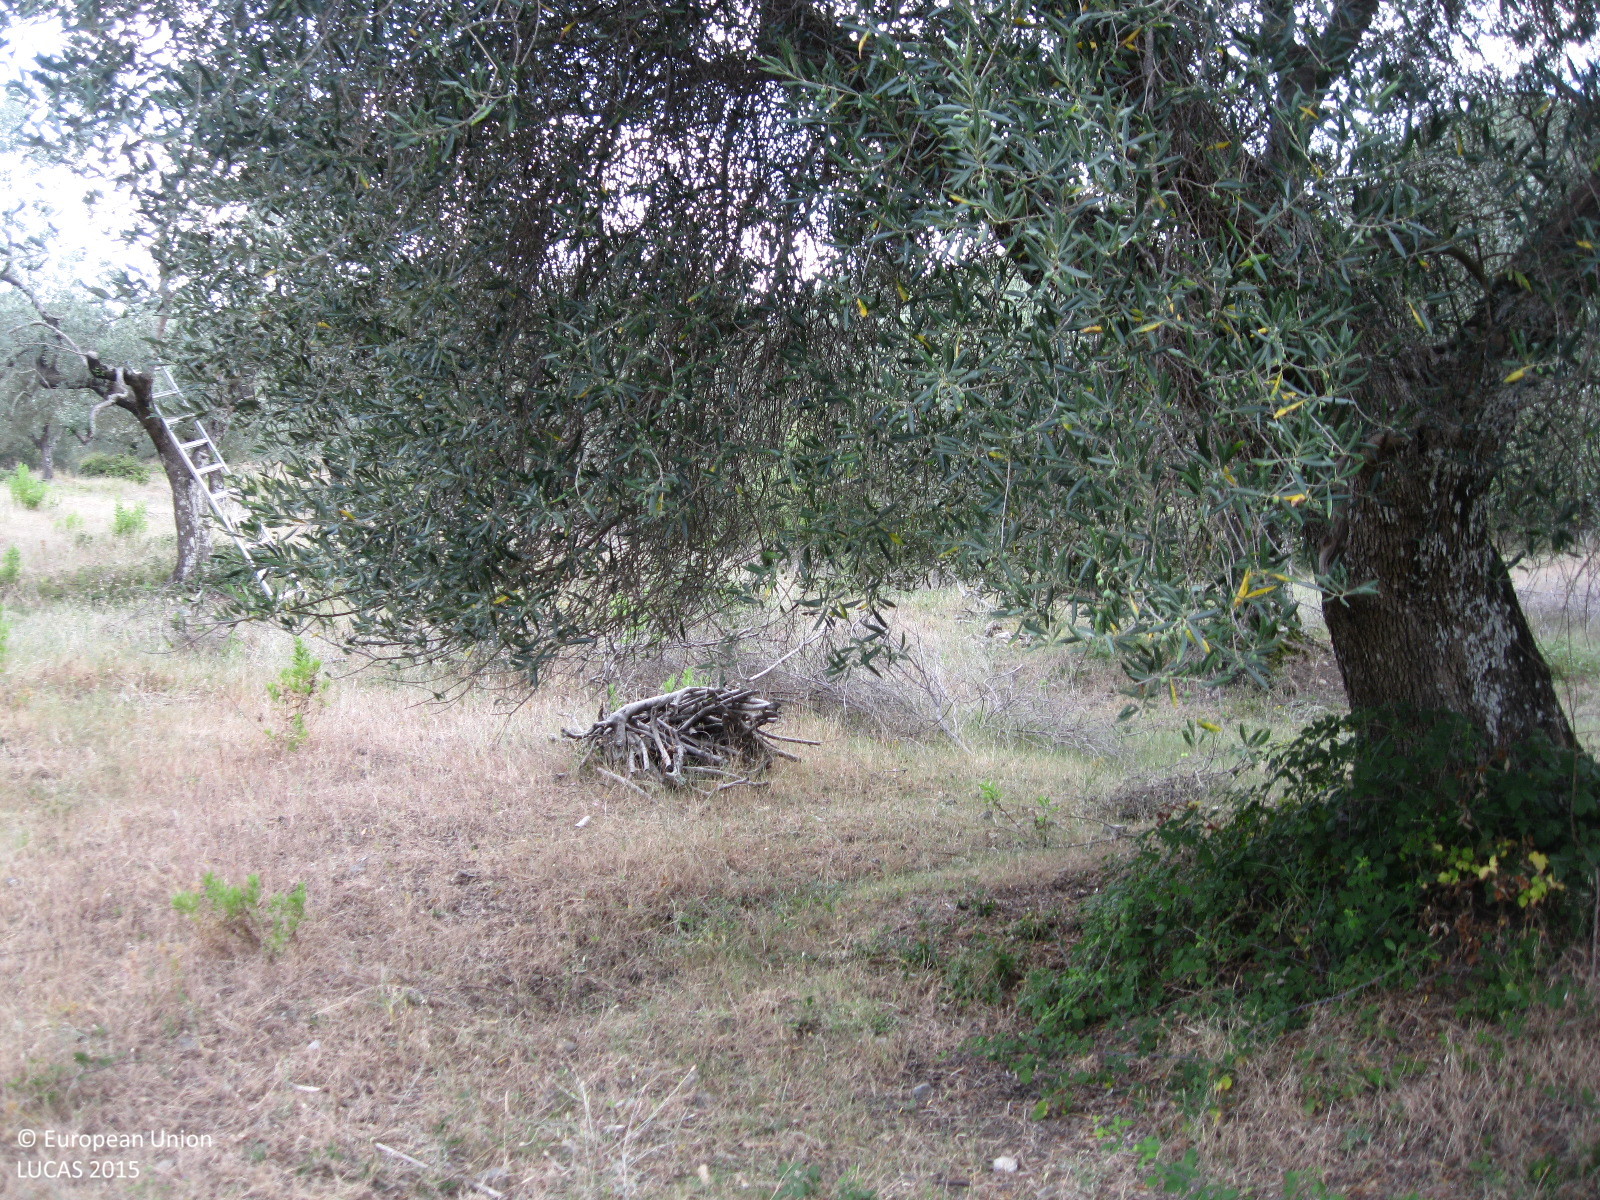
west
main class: Cropland
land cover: Olive groves
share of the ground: > 75 %
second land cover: Grassland without tree/shrub cover
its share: 50 - 75 %
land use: Agriculture (excluding fallow land and kitchen gardens)
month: July
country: IT
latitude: 42.6979
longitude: 11.4479
